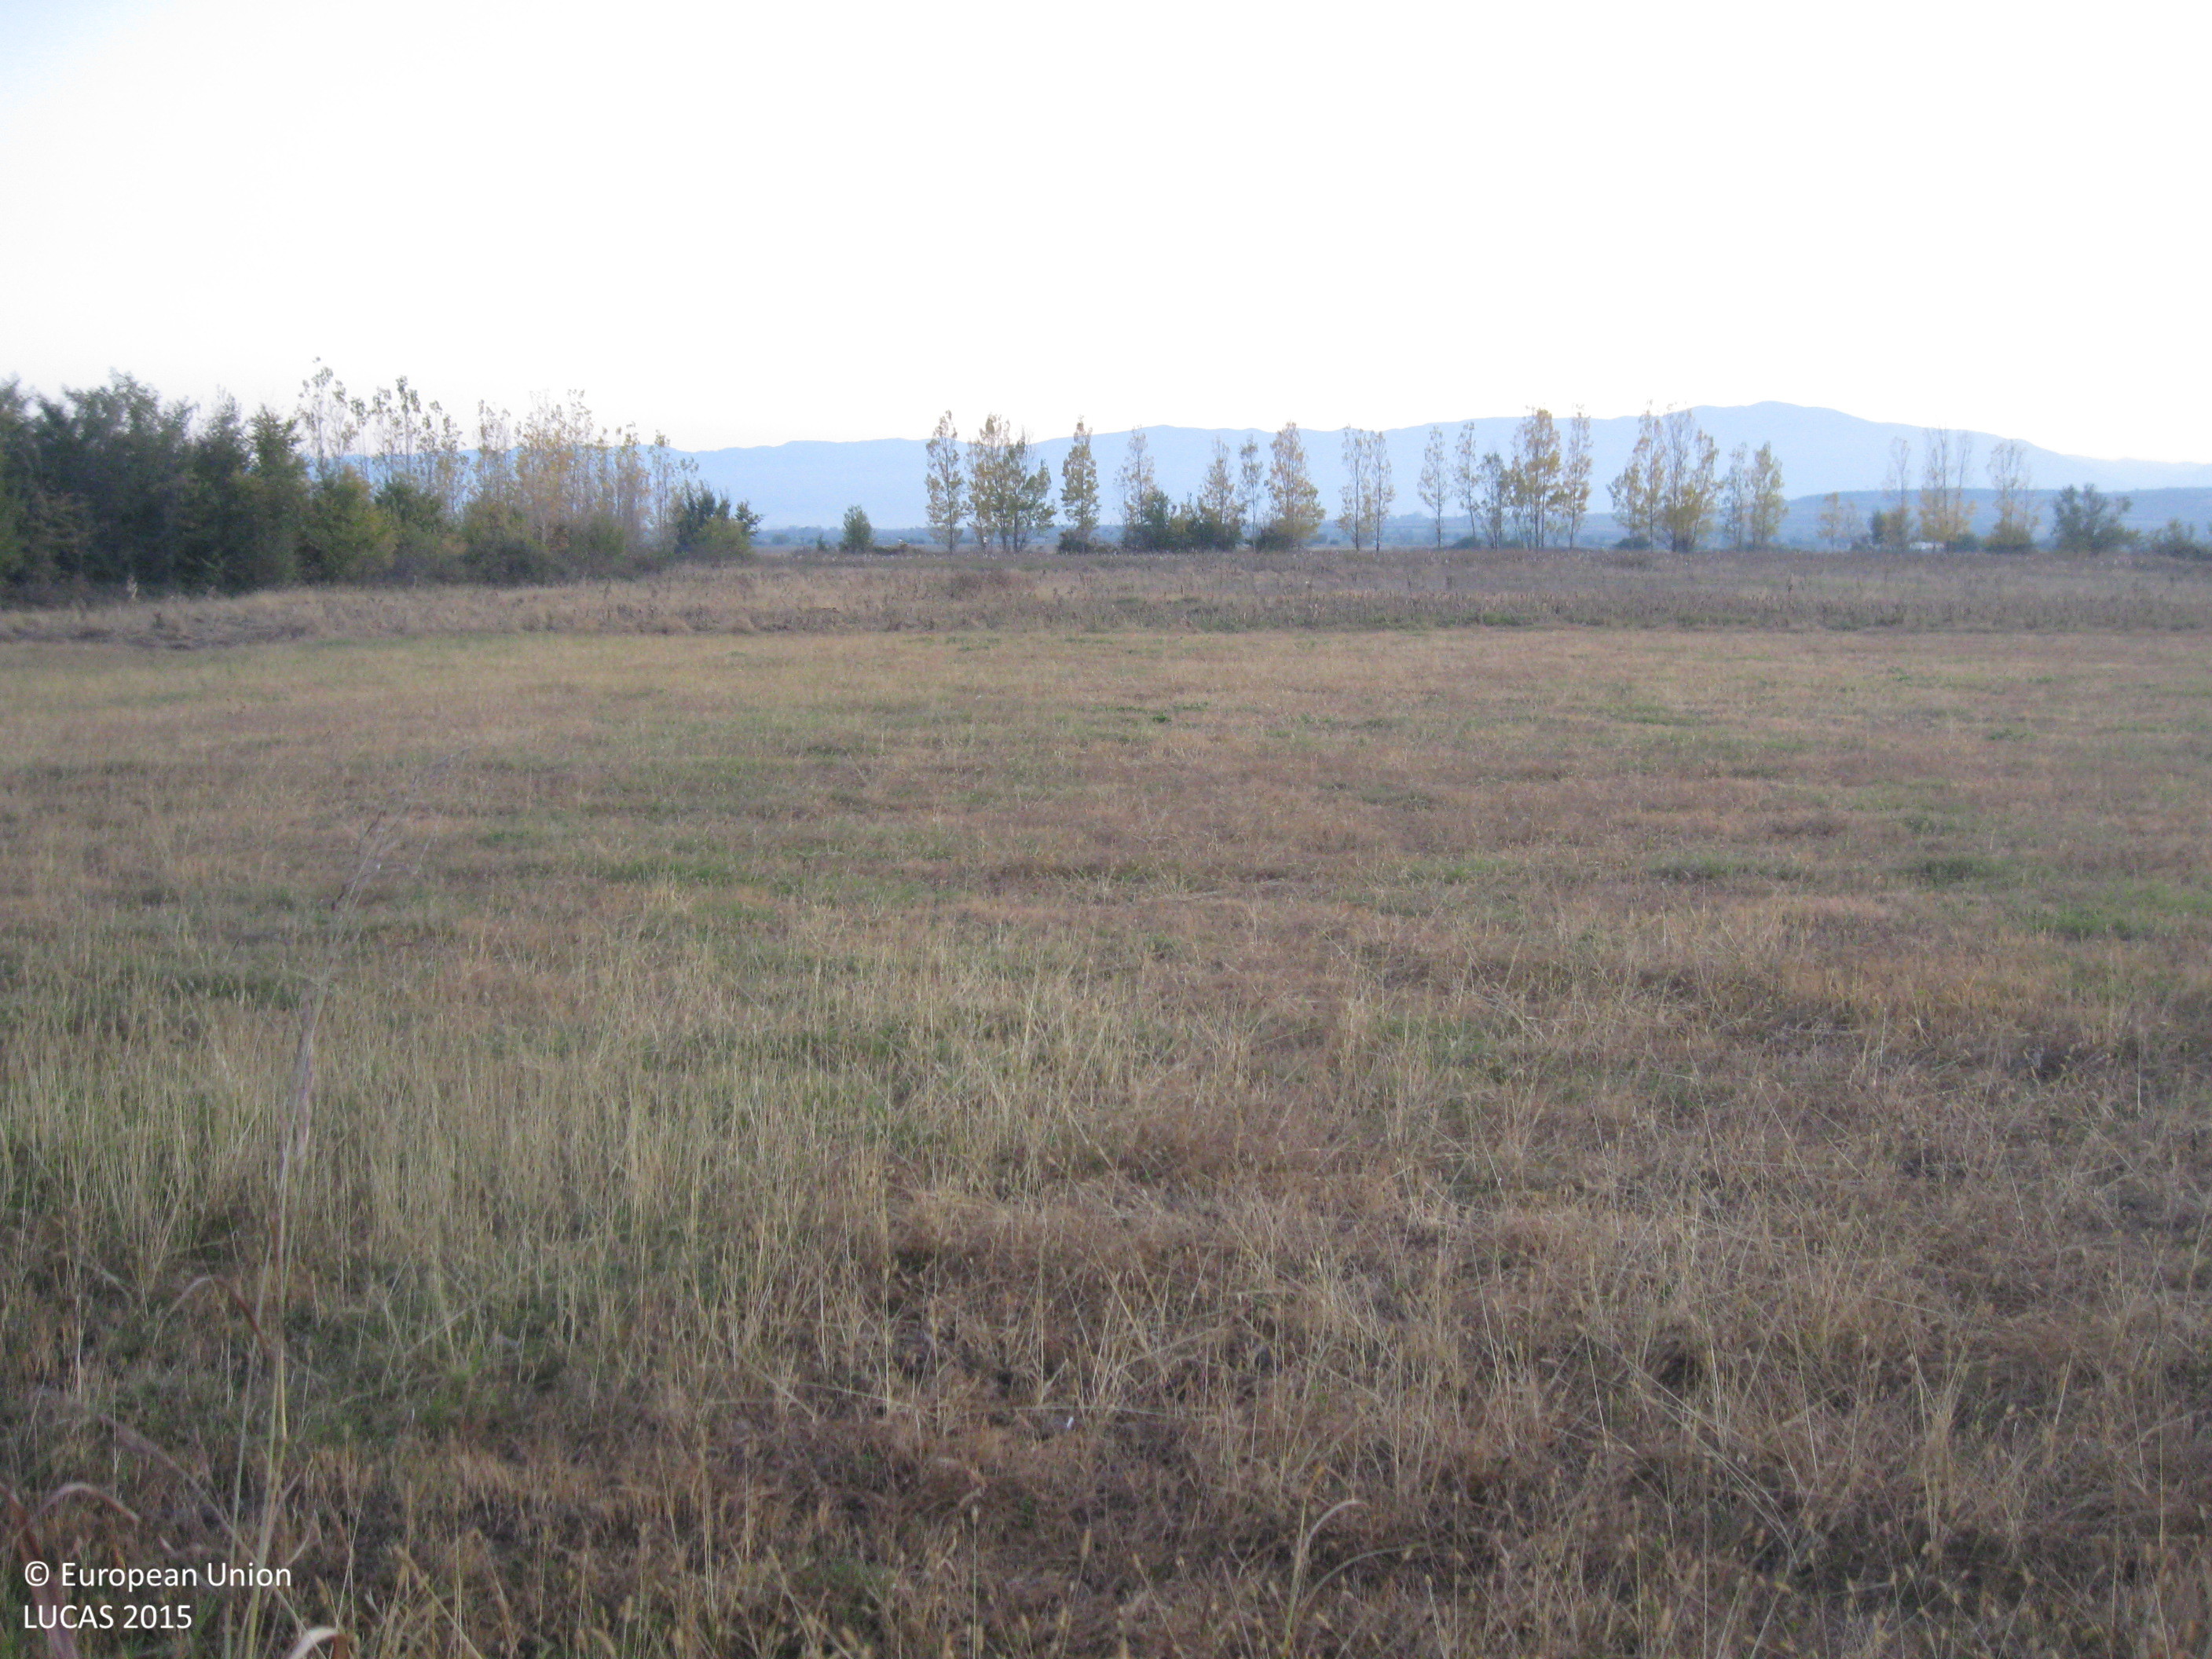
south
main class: Cropland
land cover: Maize
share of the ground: > 75 %
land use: Agriculture (excluding fallow land and kitchen gardens)
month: November
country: BG
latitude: 42.3000
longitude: 24.2487
